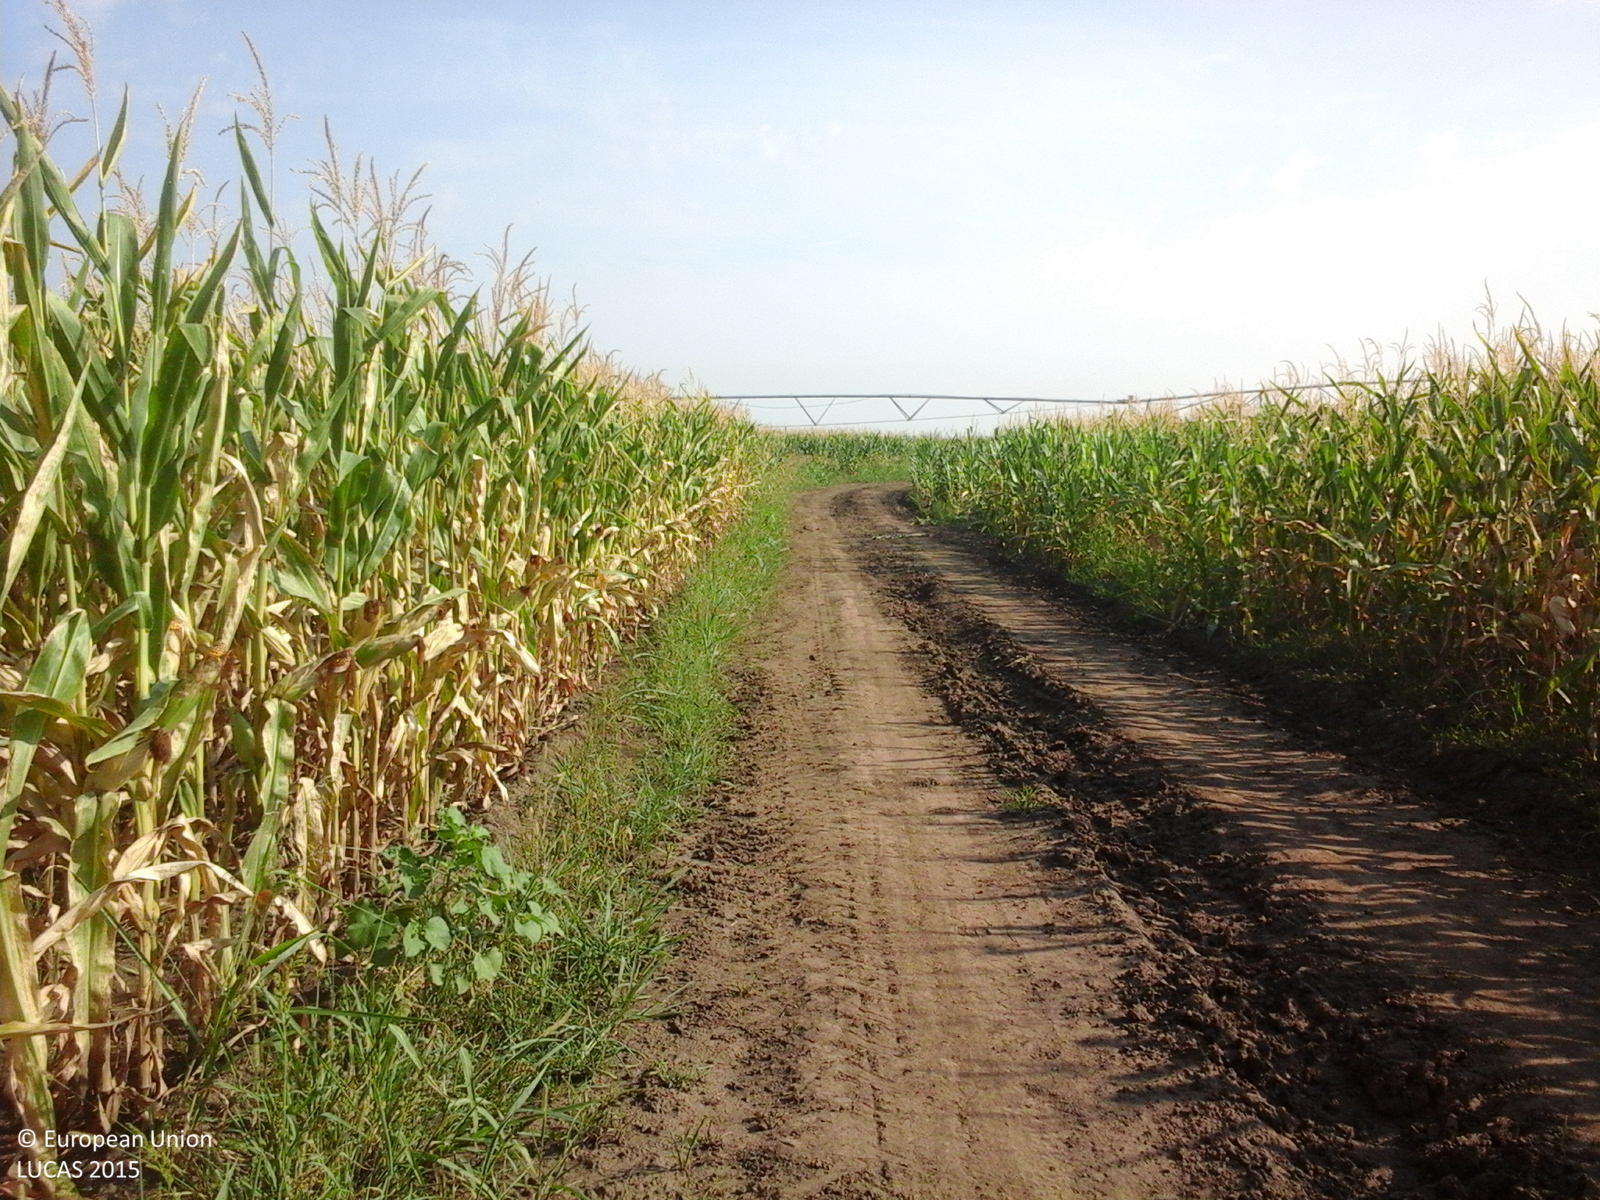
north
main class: Cropland
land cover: Maize
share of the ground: > 75 %
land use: Agriculture (excluding fallow land and kitchen gardens)
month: August
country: RO
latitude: 43.9846
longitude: 23.7044
